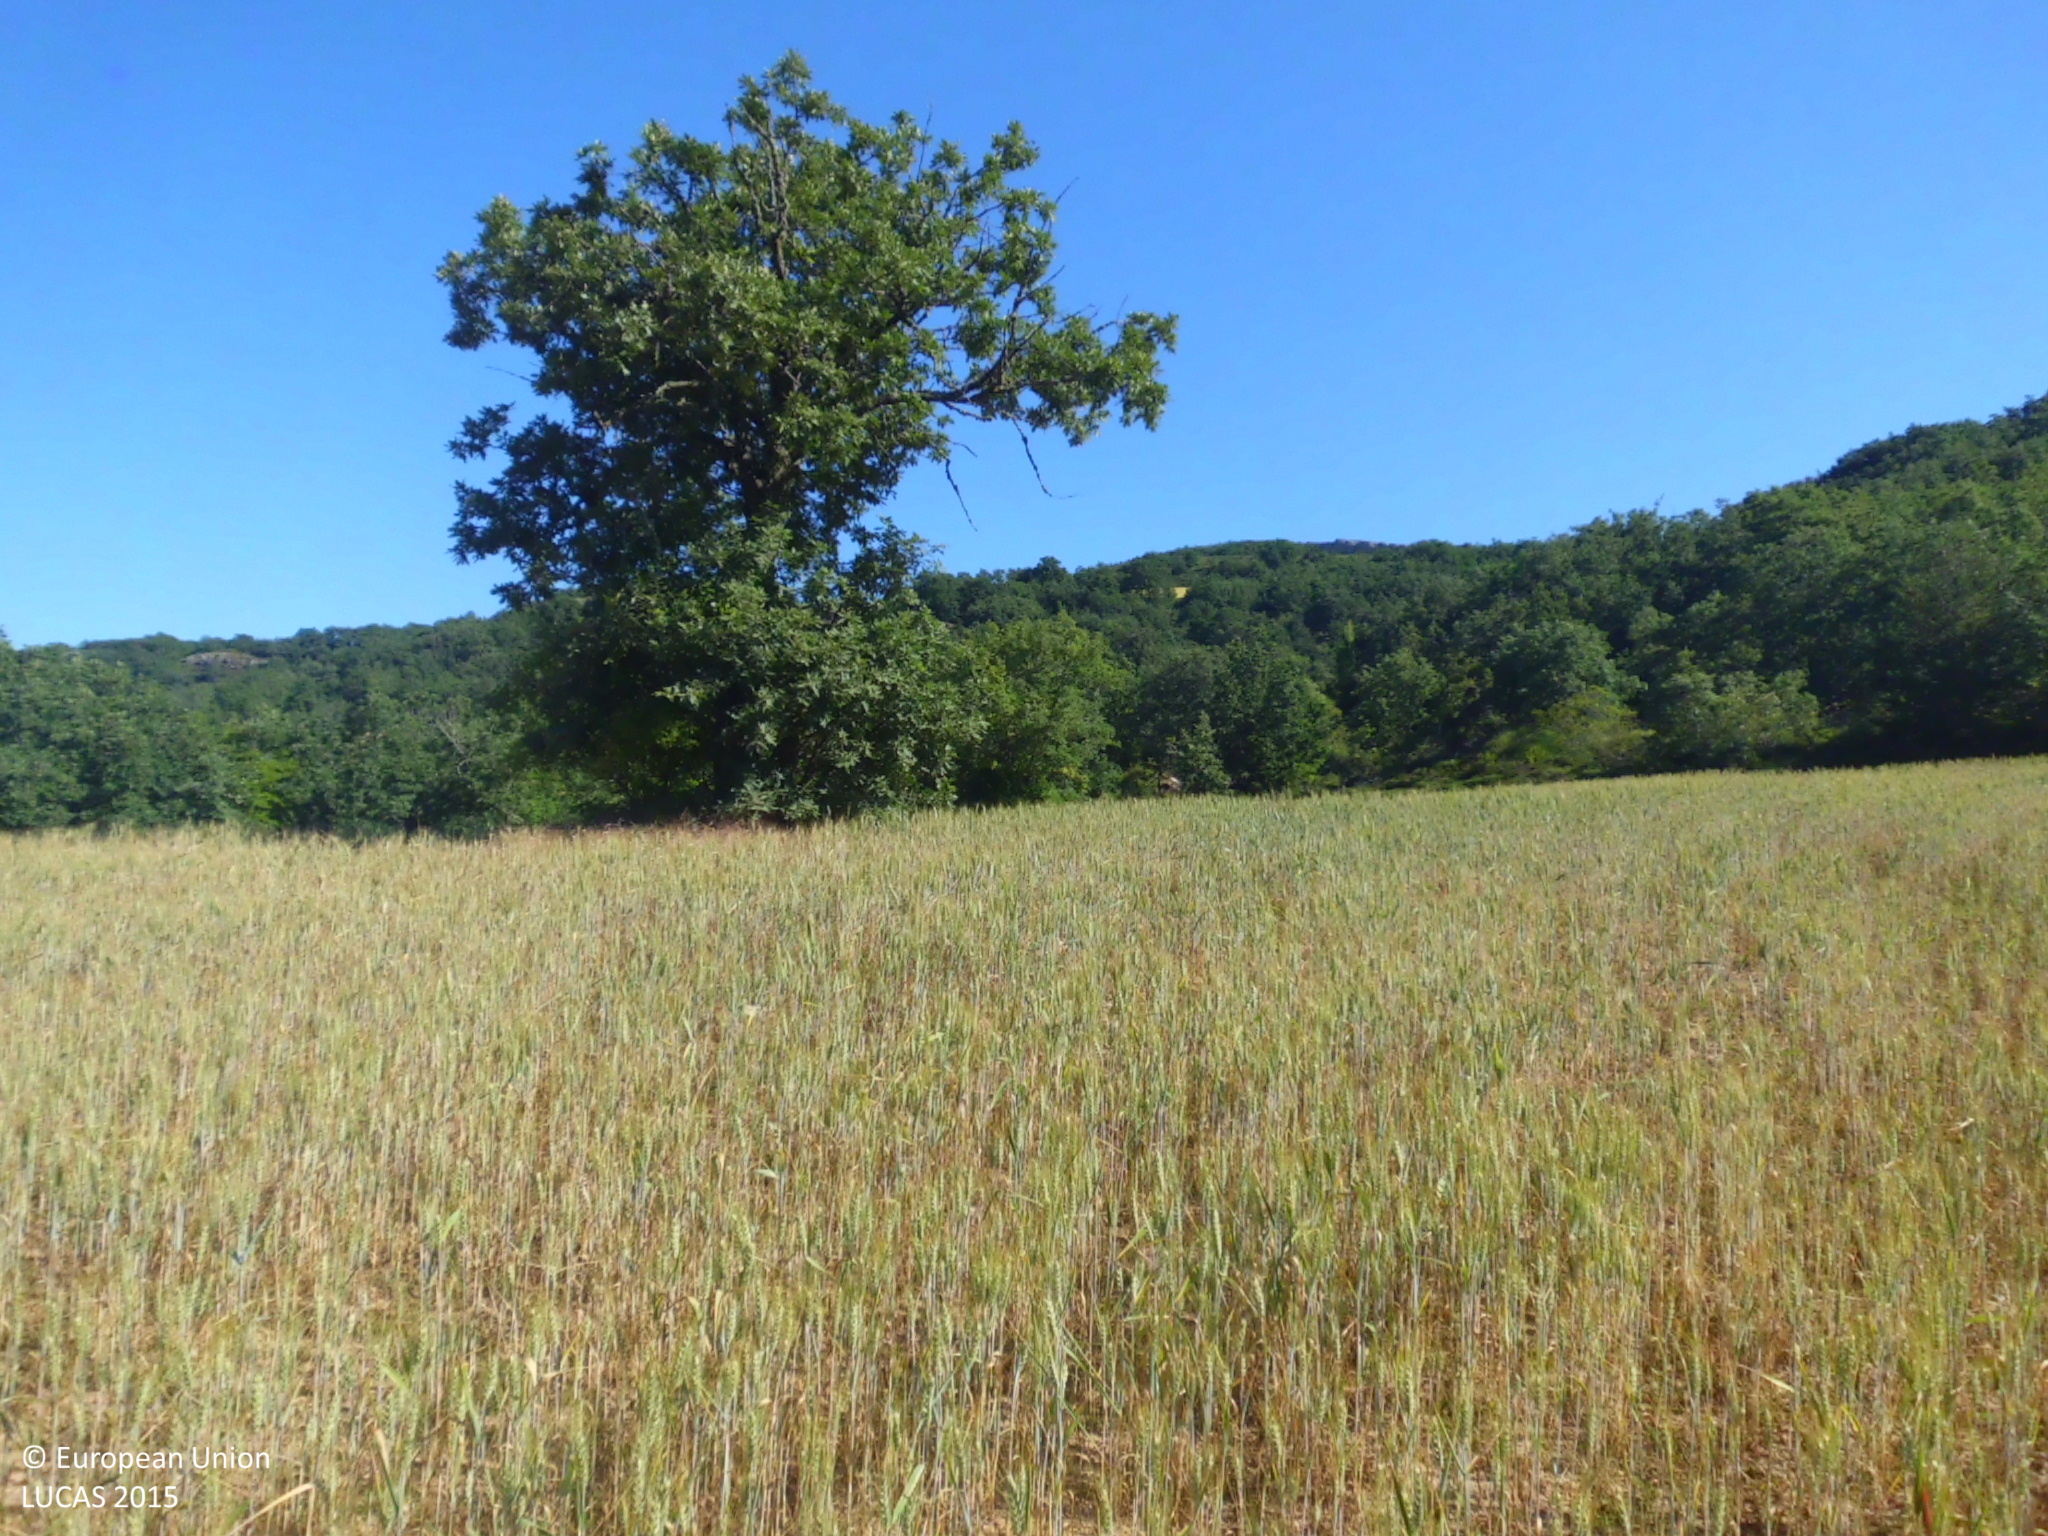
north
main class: Cropland
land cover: Common wheat
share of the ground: 25 - 50 %
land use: Agriculture (excluding fallow land and kitchen gardens)
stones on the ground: 10 - 25 %
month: June
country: ES
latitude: 42.6591
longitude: -4.0378
